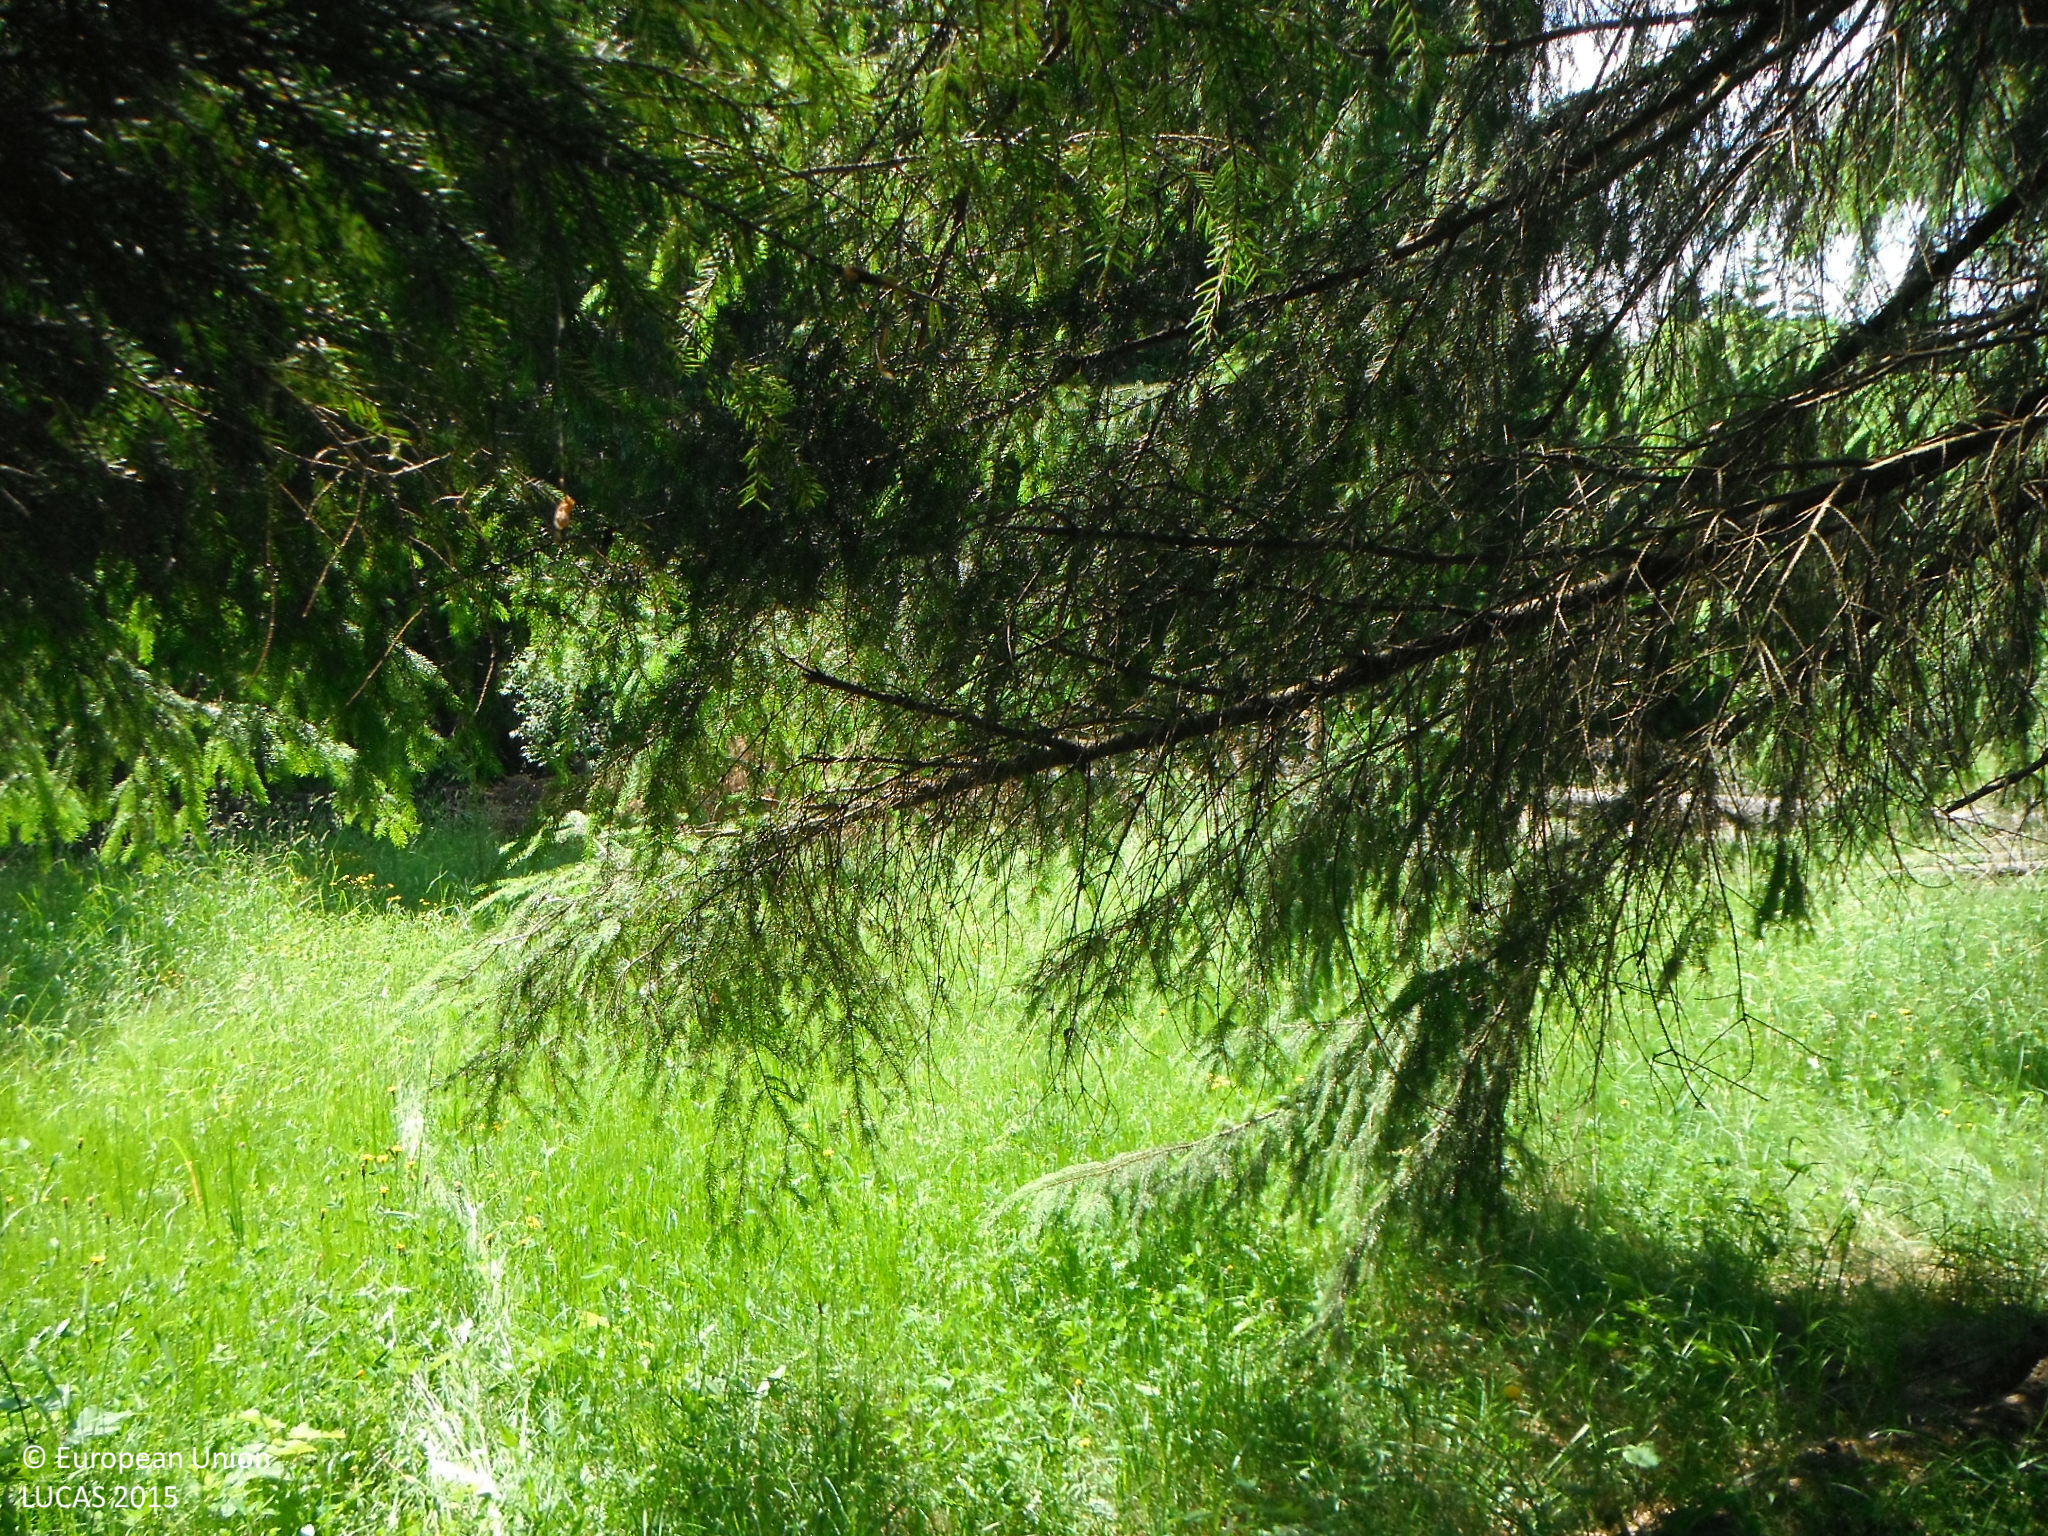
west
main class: Woodland
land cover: Spruce dominated coniferous woodland
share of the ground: > 75 %
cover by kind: coniferous forest trees 80 %, herbaceous plants 10 %, lichens and mosses 5 %, unconsolidated bare surface 5 %
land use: Forestry
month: July
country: SK
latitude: 49.3808
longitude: 19.1559
